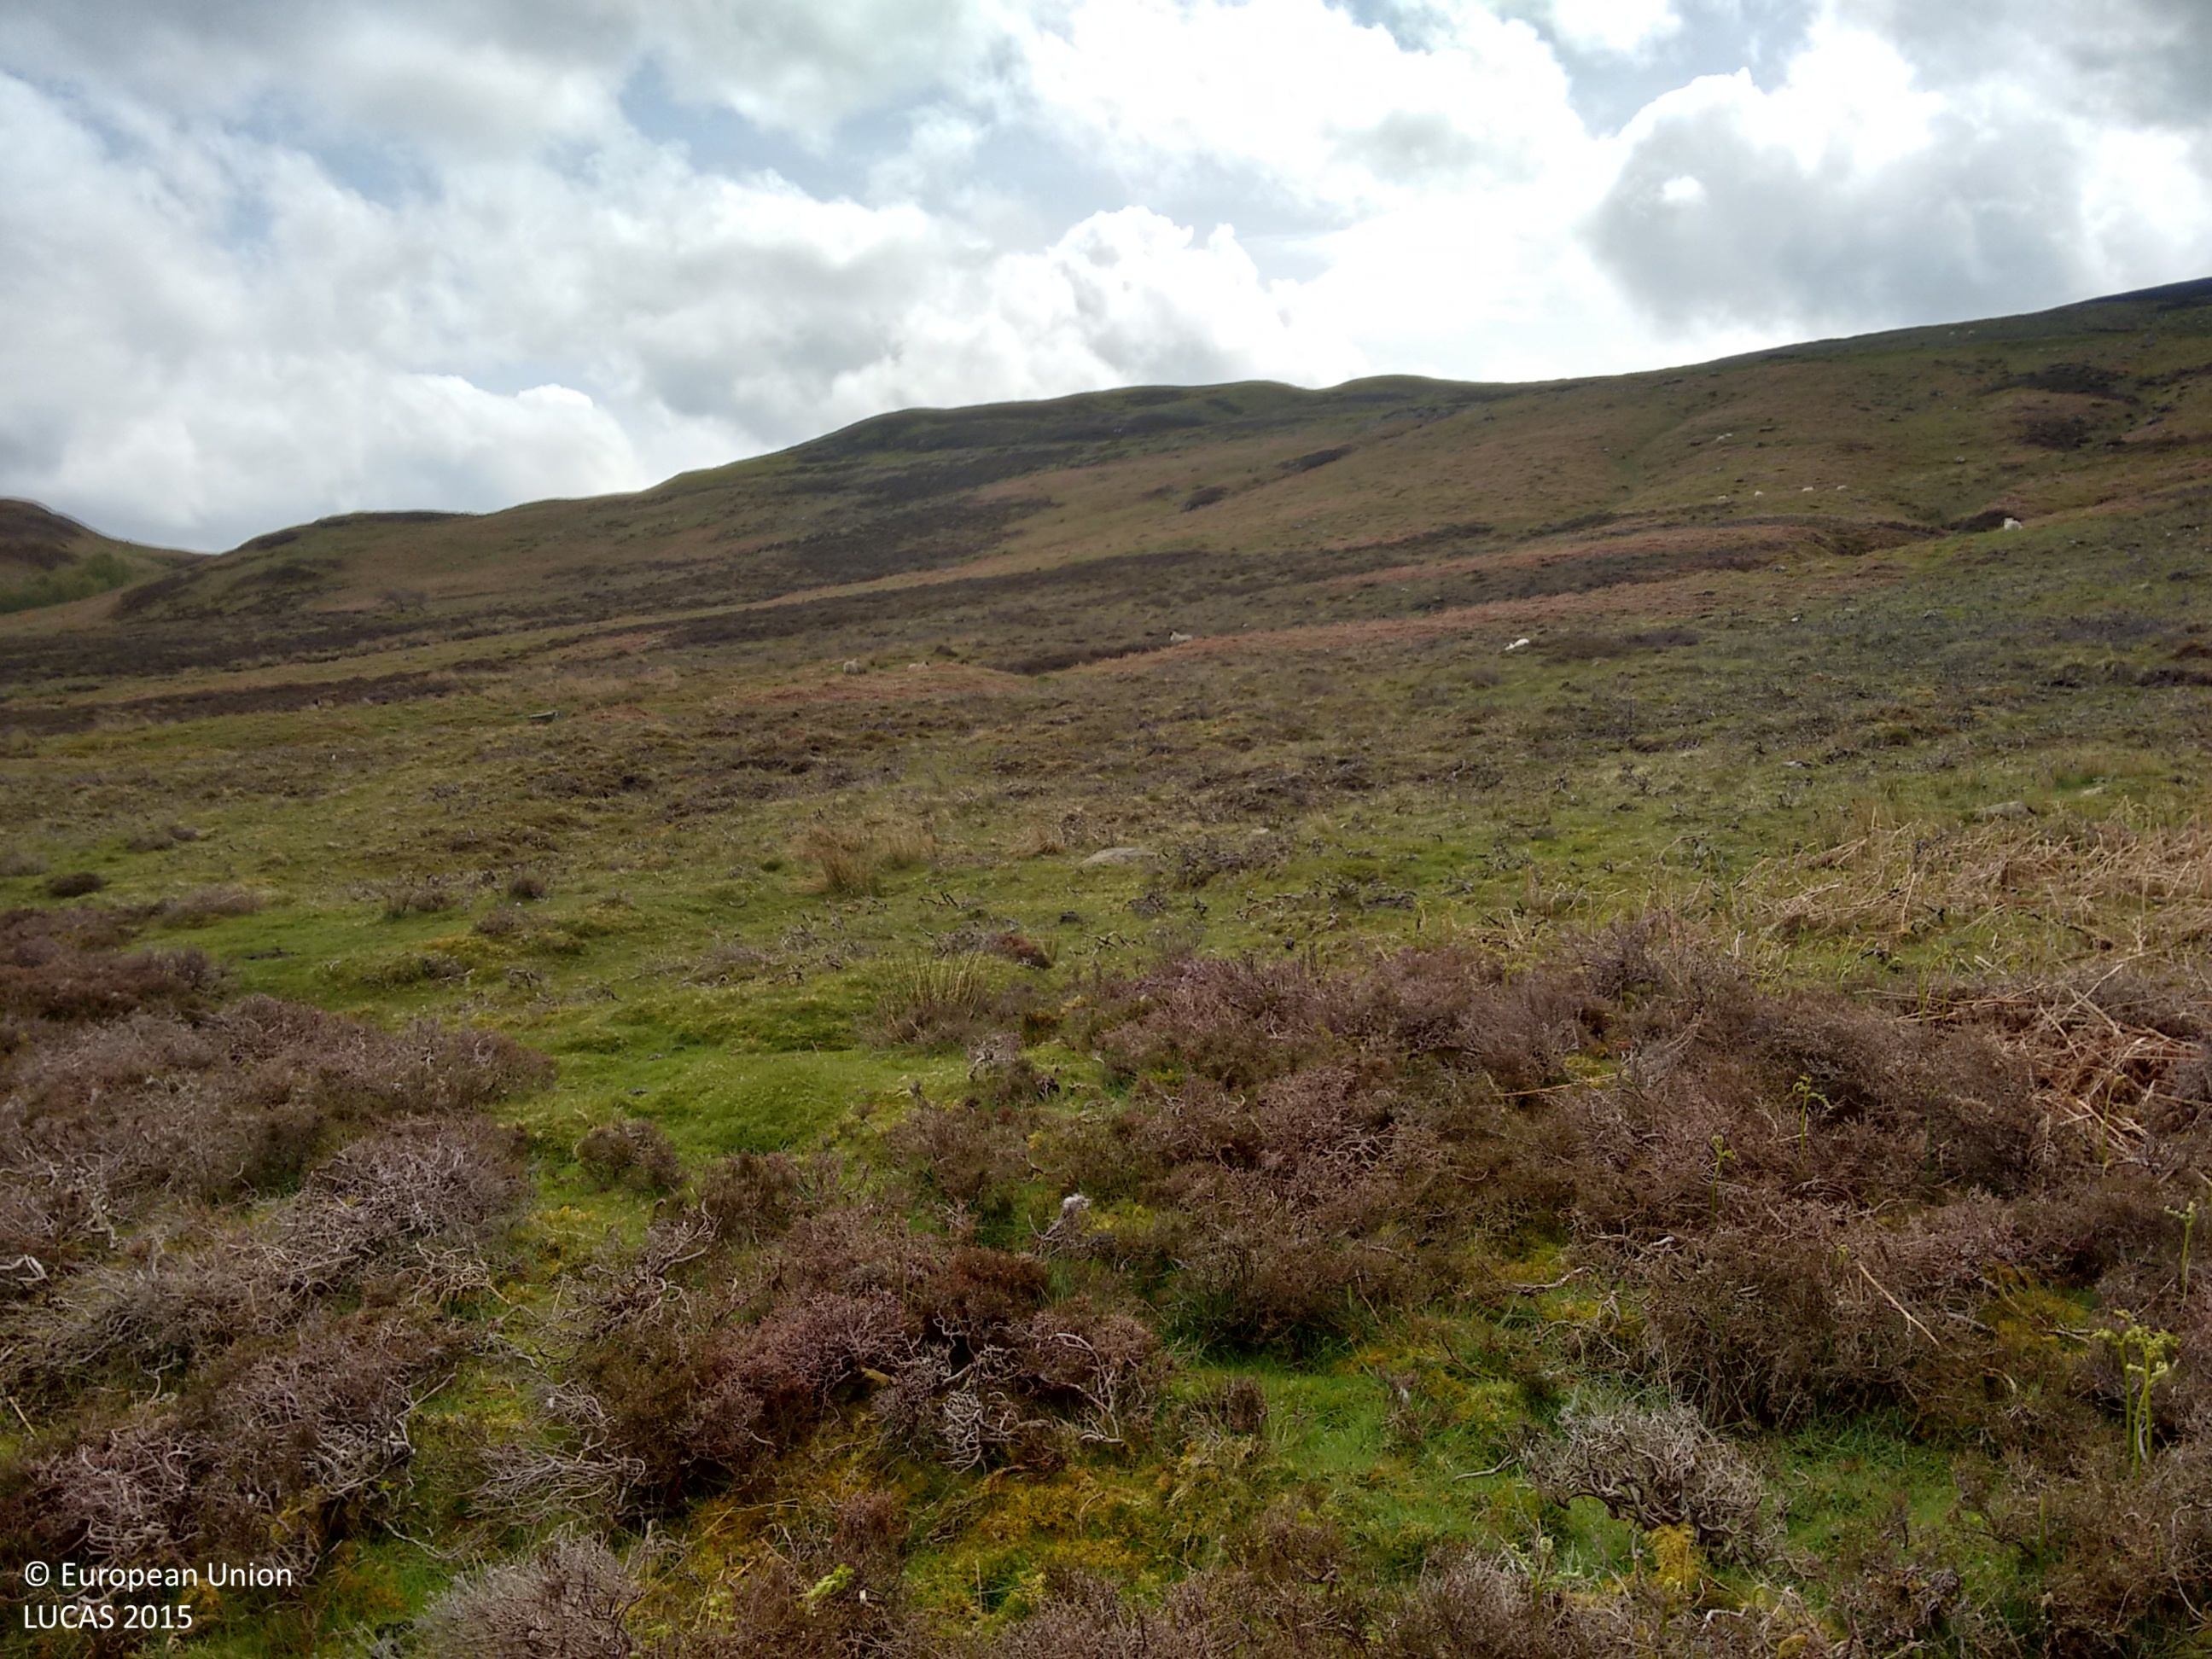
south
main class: Shrubland
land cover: Shrubland without tree cover
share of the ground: > 75 %
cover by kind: shrubs 70 %, lichens and mosses 25 %, herbaceous plants 5 %
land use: Agriculture (excluding fallow land and kitchen gardens)
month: June
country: GB
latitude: 56.4300
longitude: -4.0811
